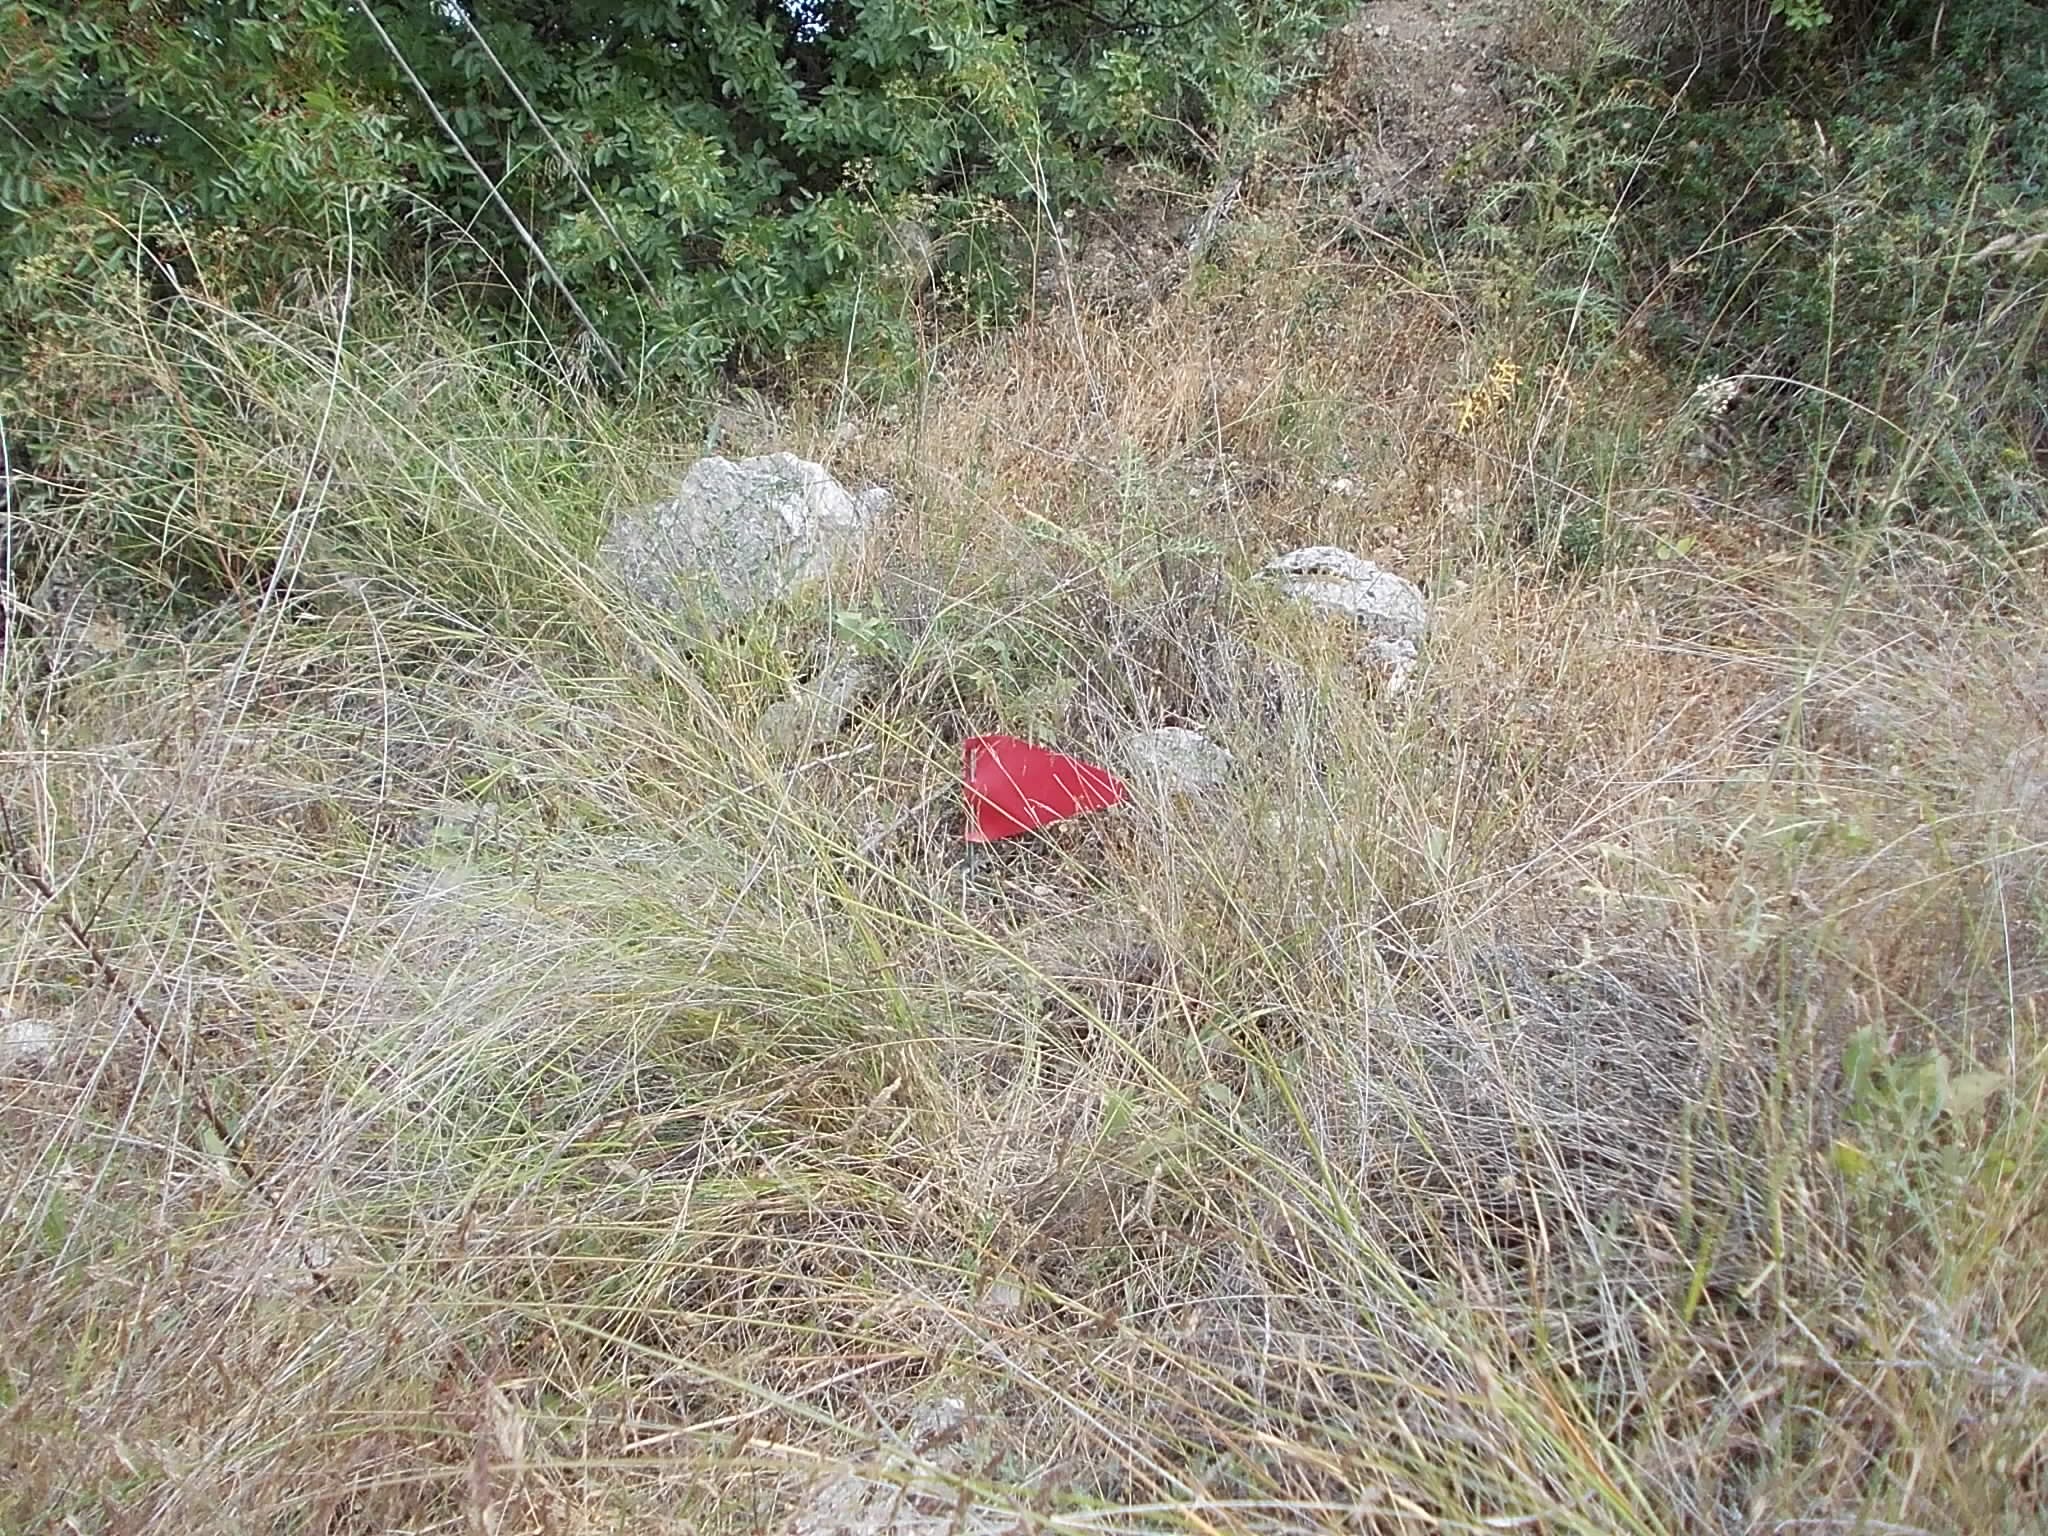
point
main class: Grassland
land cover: Grassland with sparse tree/shrub cover
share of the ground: > 75 %
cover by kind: herbaceous plants 95 %, broadleaved forest trees 5 %
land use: Semi-natural and natural areas not in use
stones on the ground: 10 - 25 %
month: June
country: CY
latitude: 34.8278
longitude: 32.9411
